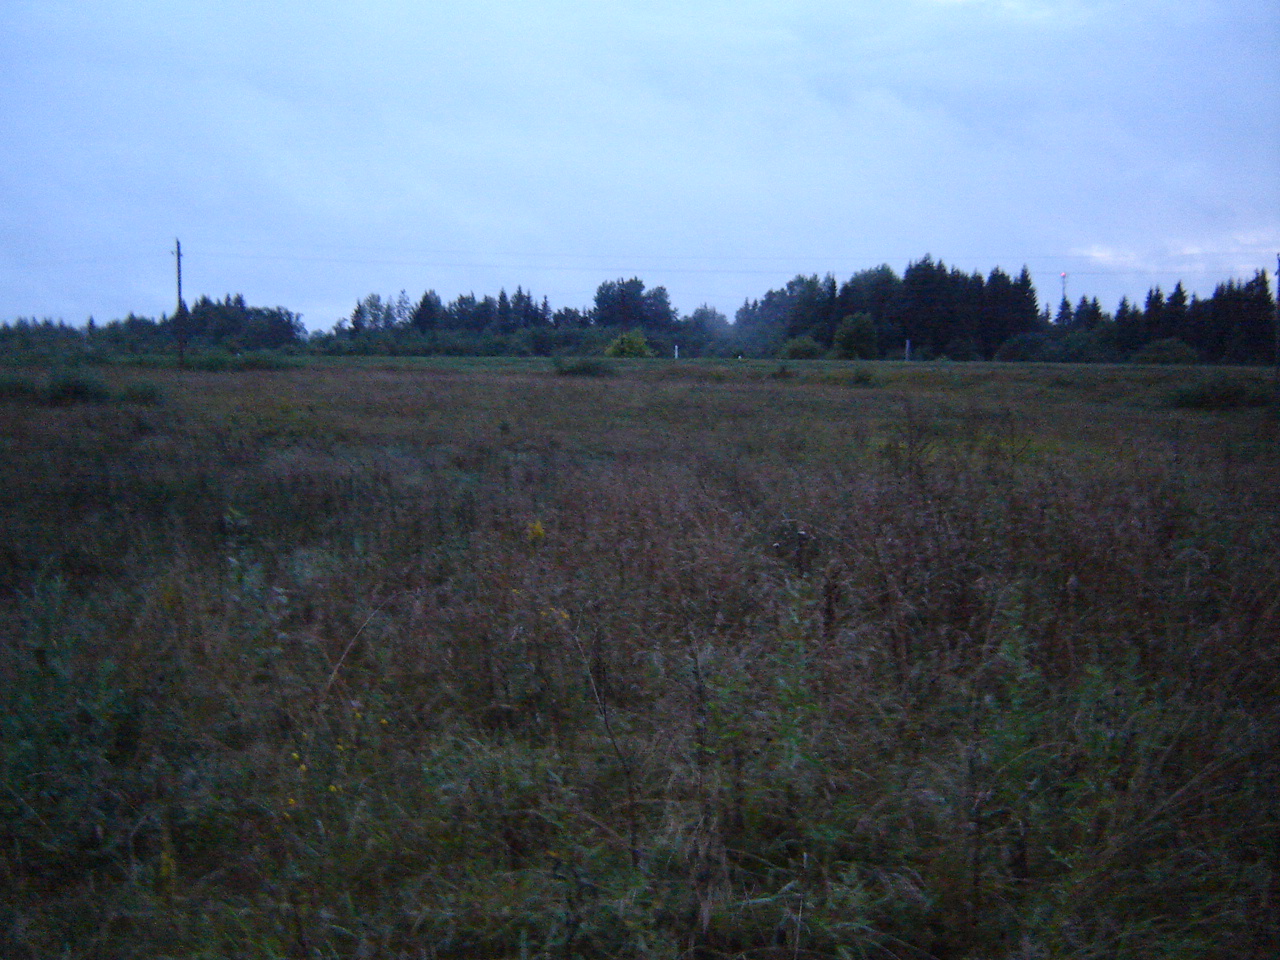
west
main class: Grassland
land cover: Spontaneously vegetated surfaces
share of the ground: > 75 %
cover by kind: herbaceous plants 100 %
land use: Fallow land
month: September
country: LT
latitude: 54.9276
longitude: 25.3368
